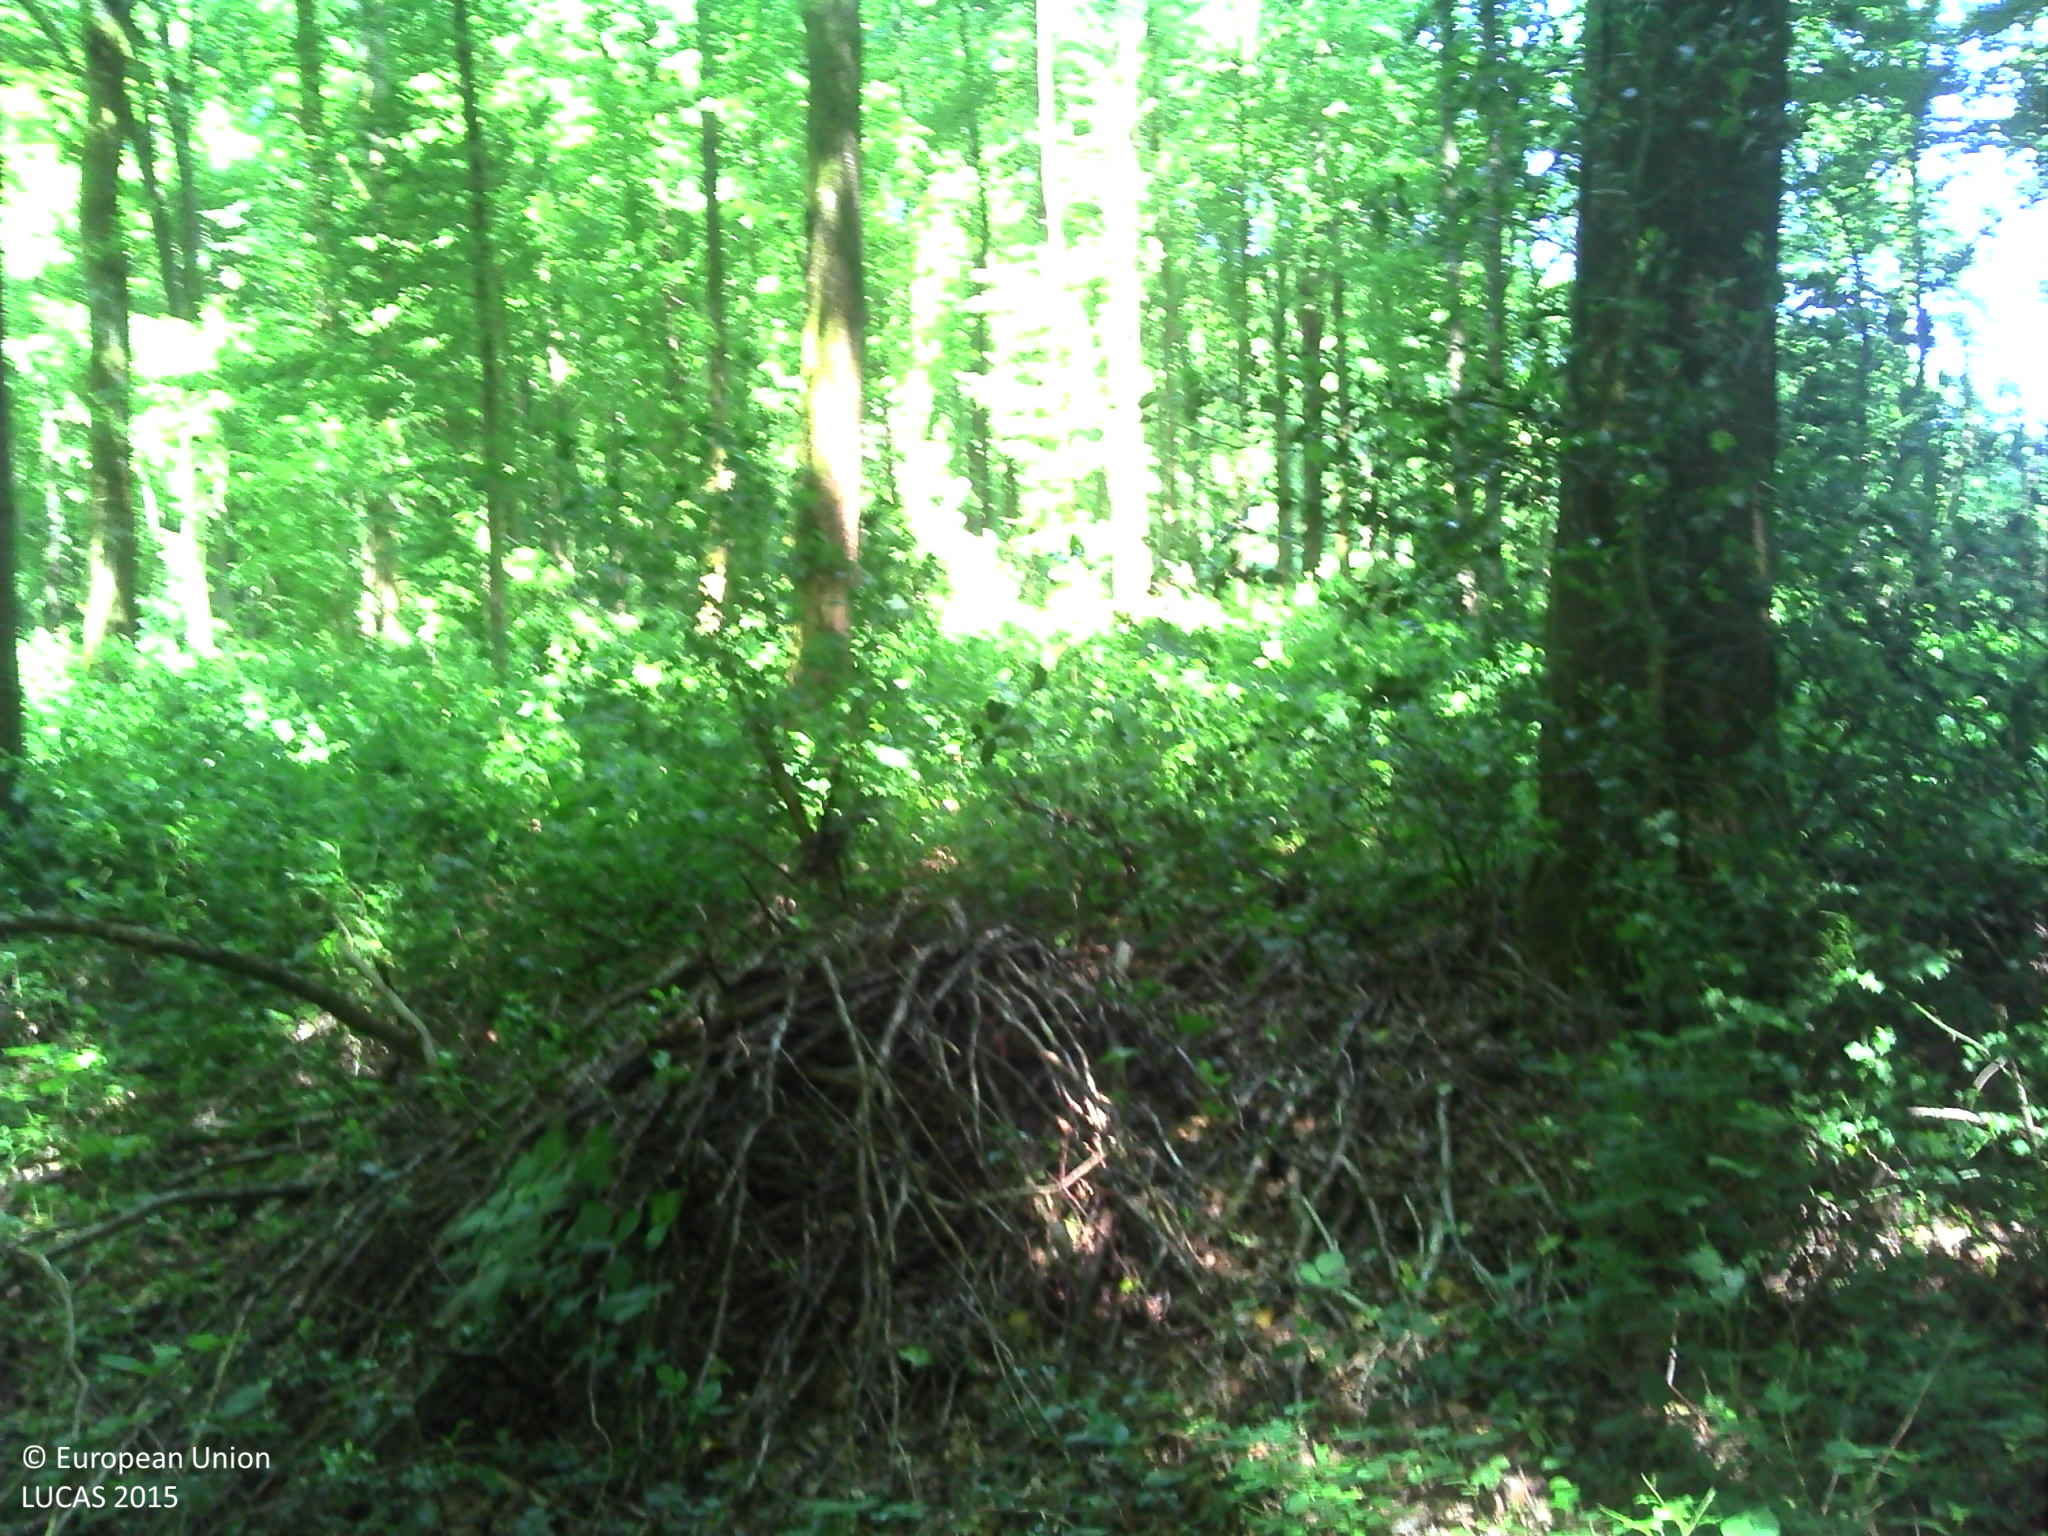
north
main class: Woodland
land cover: Broadleaved woodland
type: mesophytic deciduous forest
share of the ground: > 75 %
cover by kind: broadleaved forest trees 80 %, shrubs 10 %, herbaceous plants 10 %
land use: Forestry
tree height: > 5 m
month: June
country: FR
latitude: 49.9084
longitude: 4.1606
